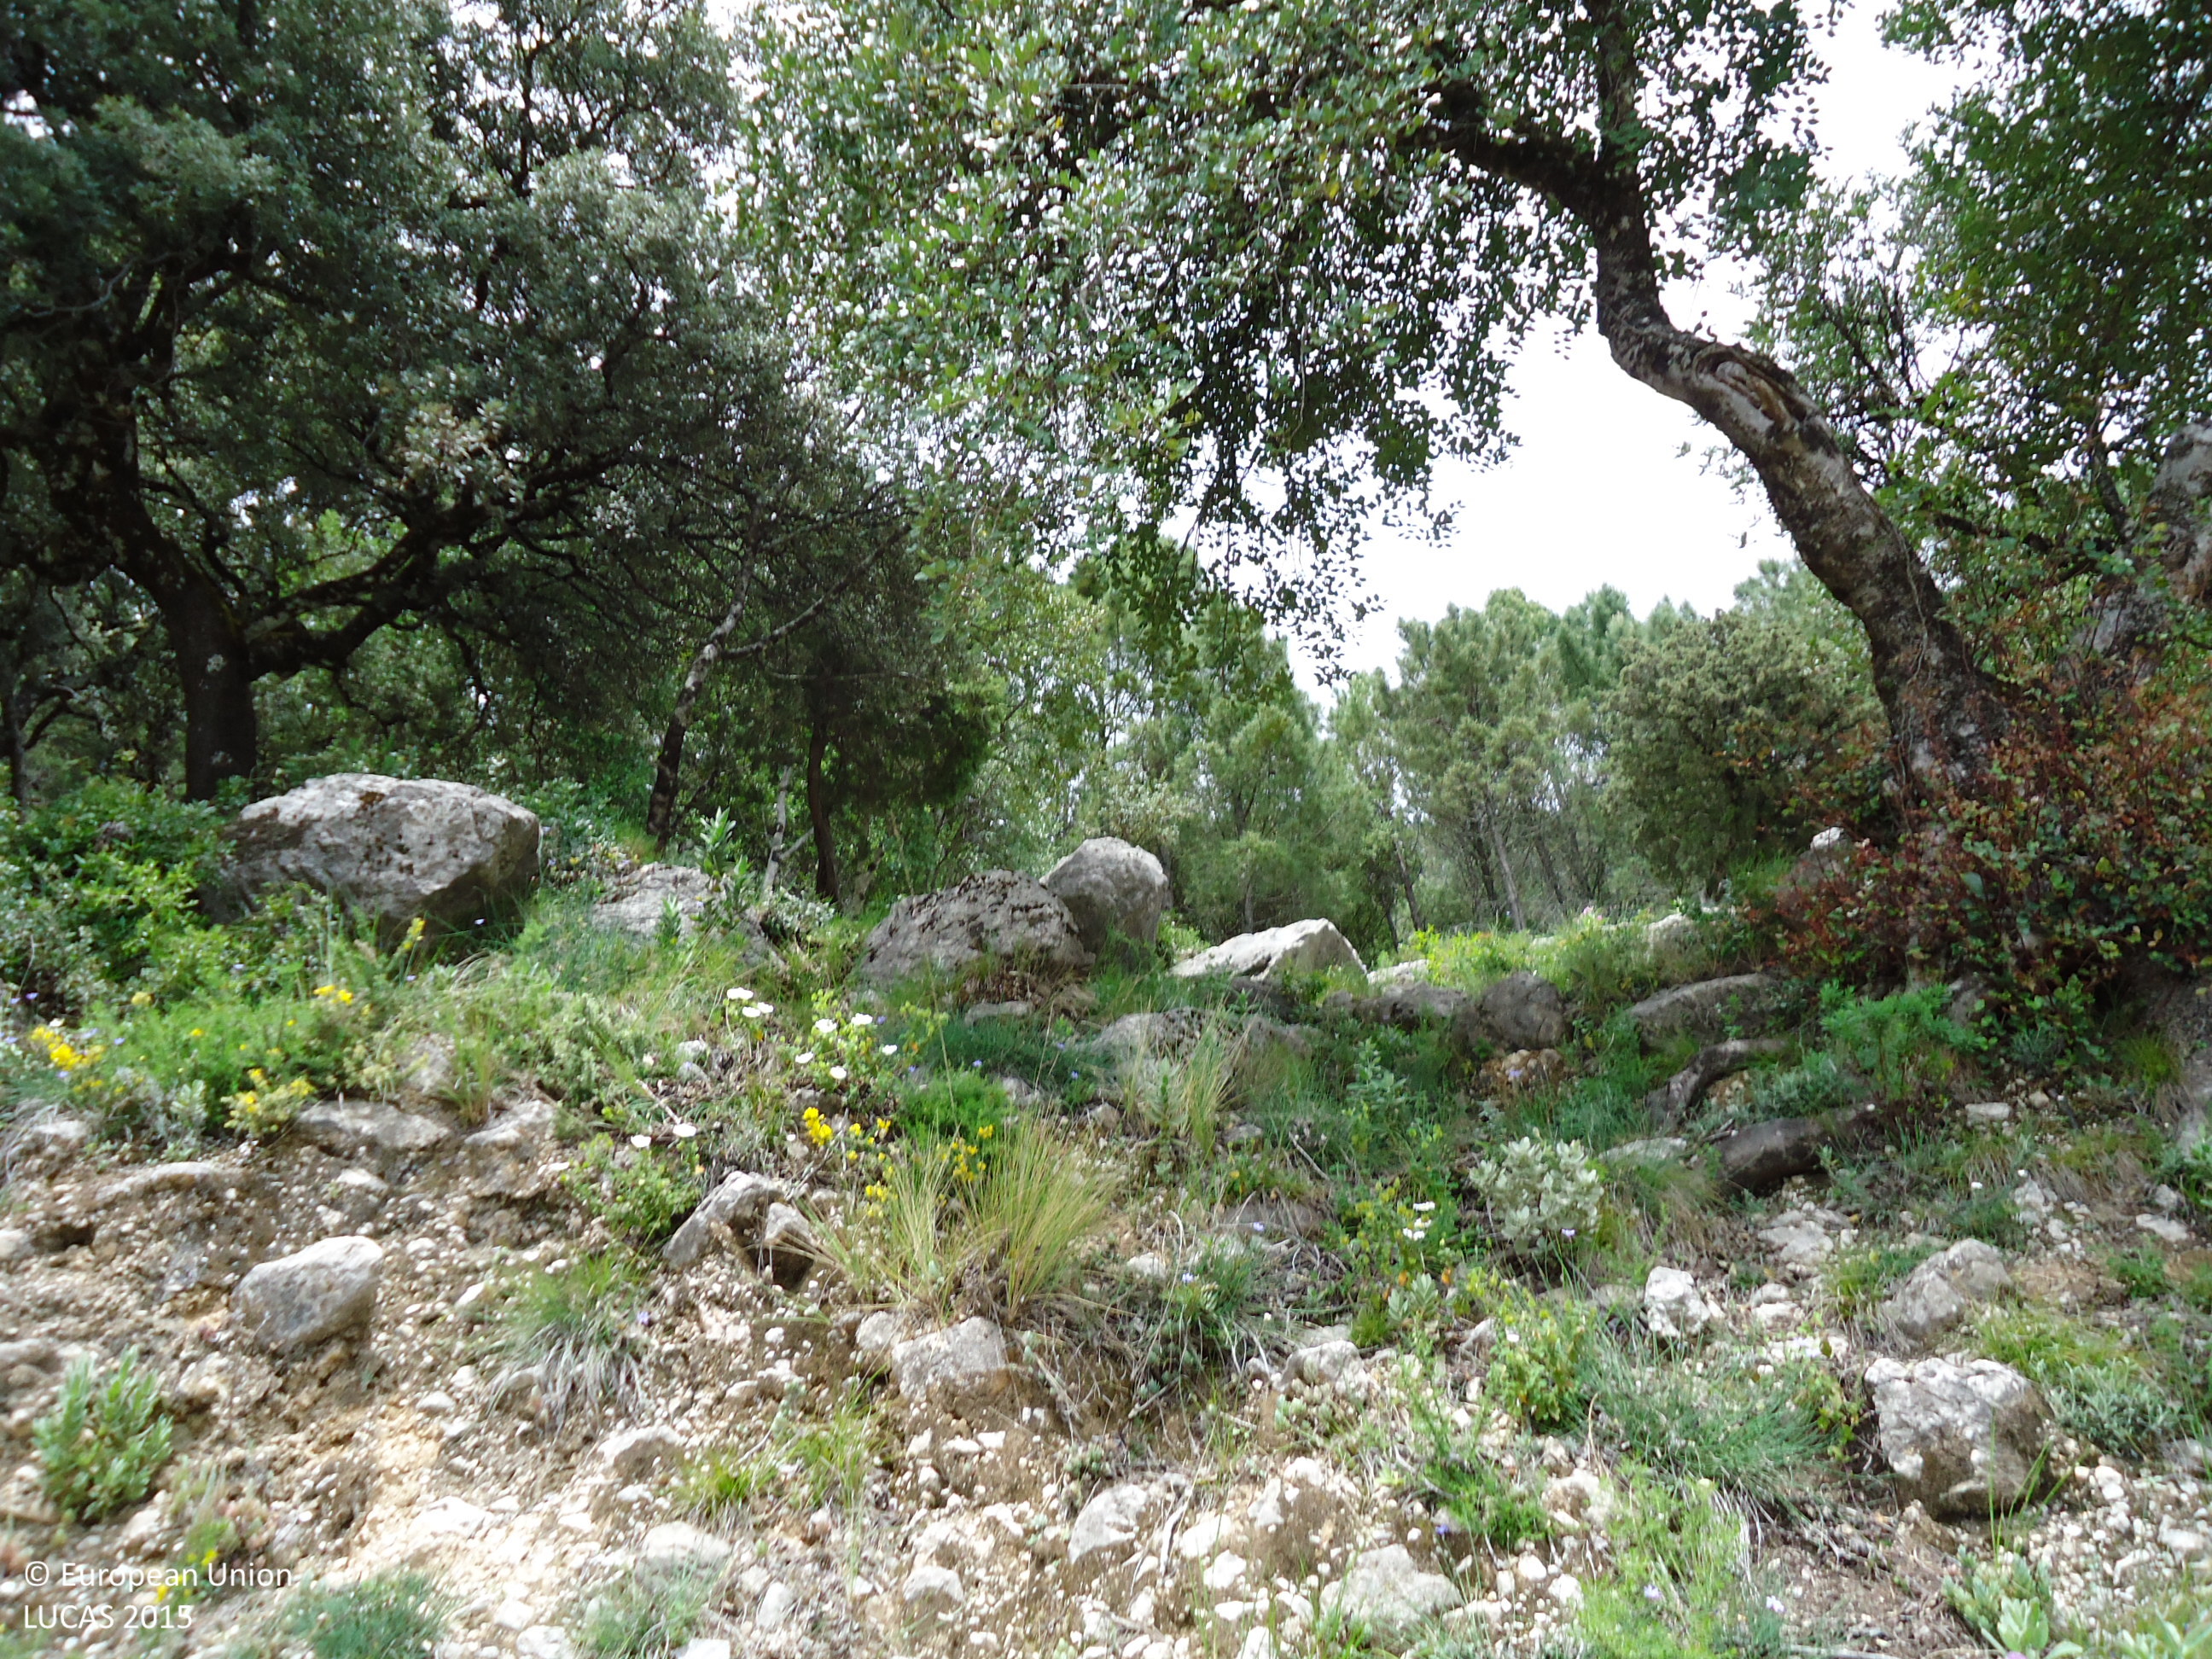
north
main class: Woodland
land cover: Broadleaved woodland
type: broadleaved evergreen forest
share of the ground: > 75 %
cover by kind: broadleaved forest trees 80 %, shrubs 10 %, coniferous forest trees 5 %, herbaceous plants 5 %
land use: Semi-natural and natural areas not in use
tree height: > 5 m
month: May
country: ES
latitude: 36.7567
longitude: -5.4274
